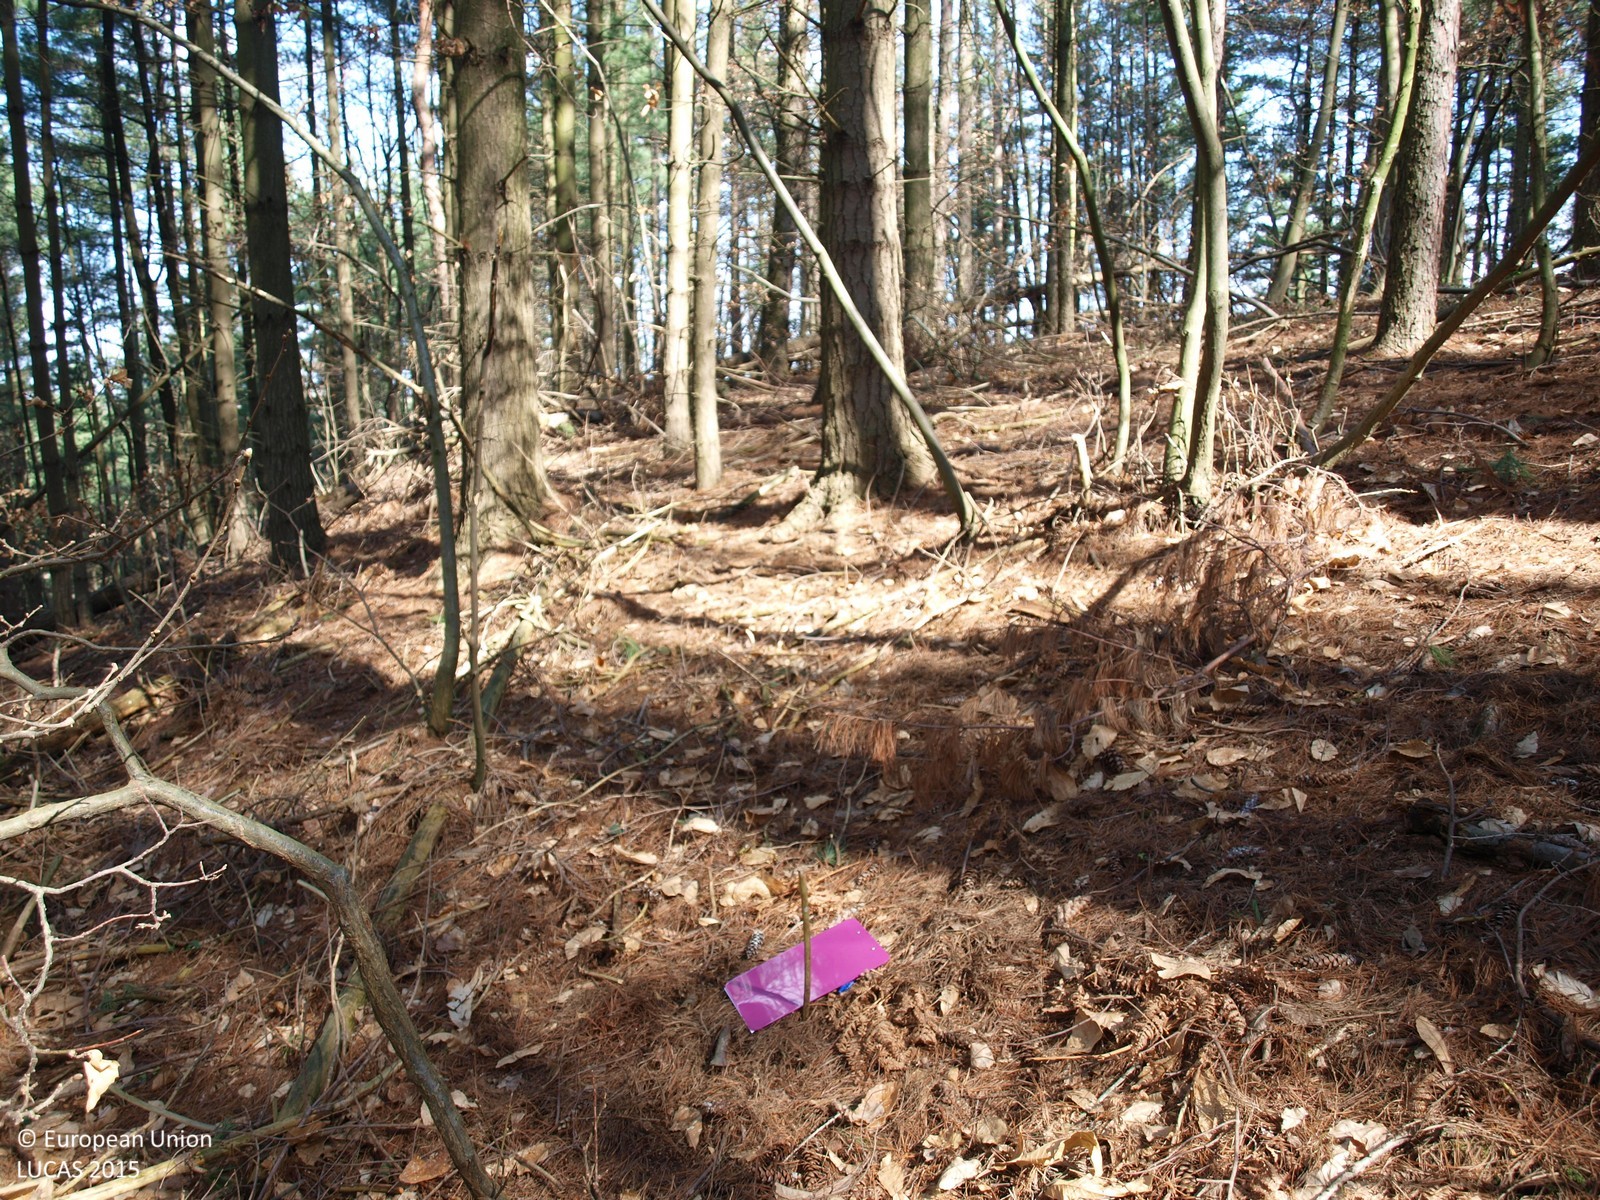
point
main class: Woodland
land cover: Pine dominated coniferous woodland
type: hemiboreal forest and nemoral coniferous forest and mixed broadleaved-coniferous forest
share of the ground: > 75 %
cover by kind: coniferous forest trees 95 %, broadleaved forest trees 5 %
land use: Forestry
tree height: > 5 m
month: March
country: HR
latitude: 46.3371
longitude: 16.1447
